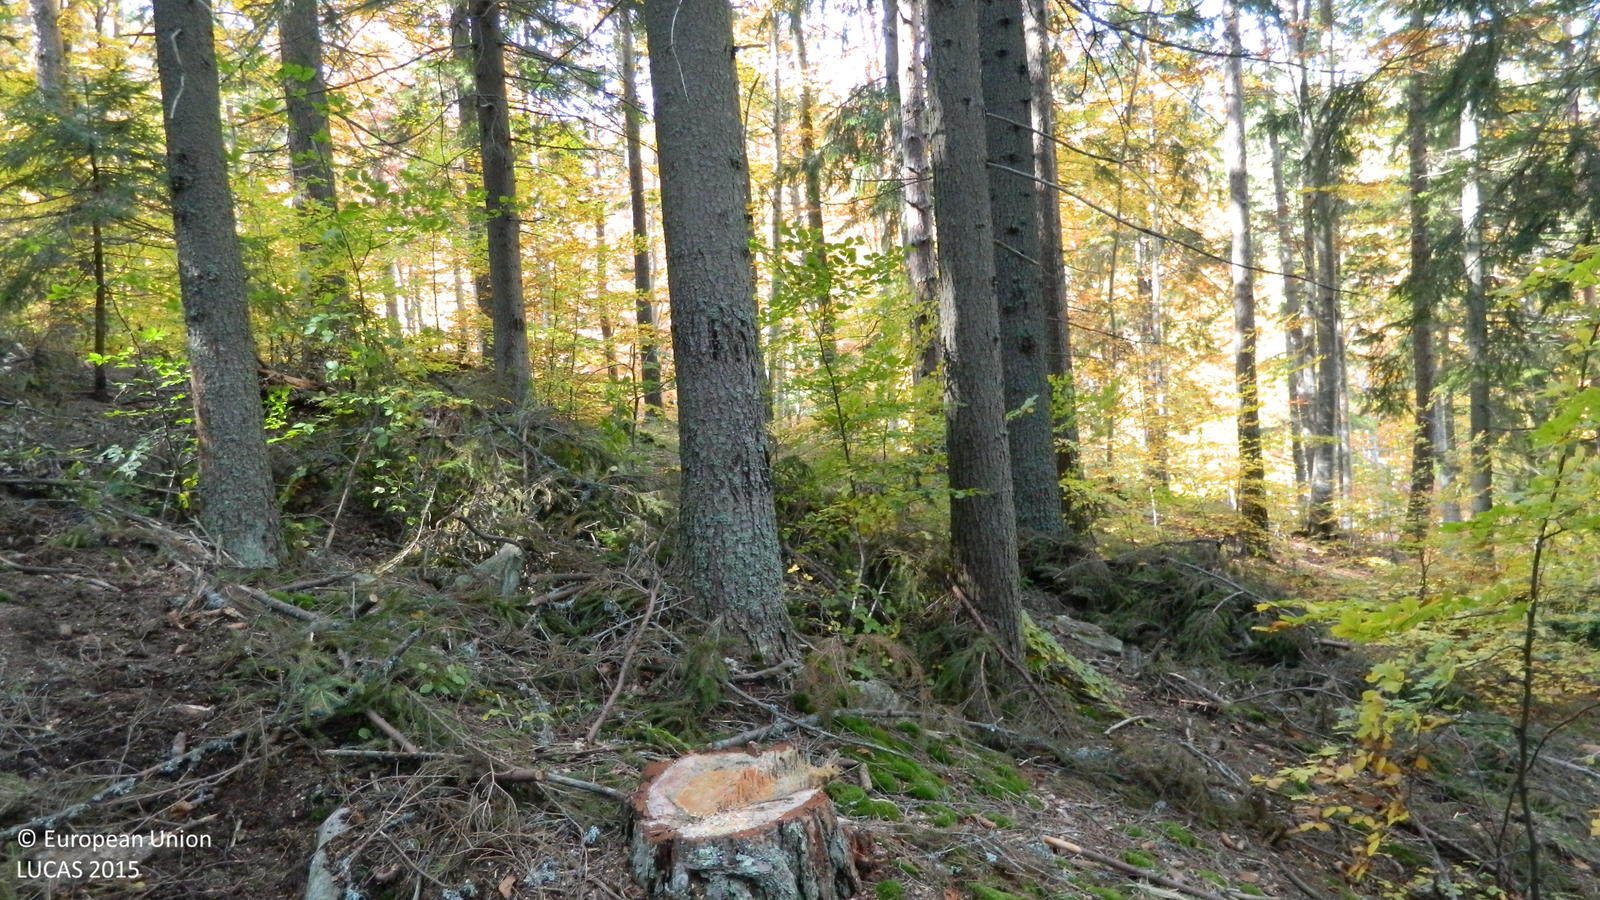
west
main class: Woodland
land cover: Spruce dominated mixed woodland
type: alpine coniferous forest
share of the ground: > 75 %
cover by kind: coniferous forest trees 75 %, broadleaved forest trees 25 %
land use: Forestry
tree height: > 5 m
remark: Clear cut
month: October
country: BG
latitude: 41.6934
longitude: 24.8874
